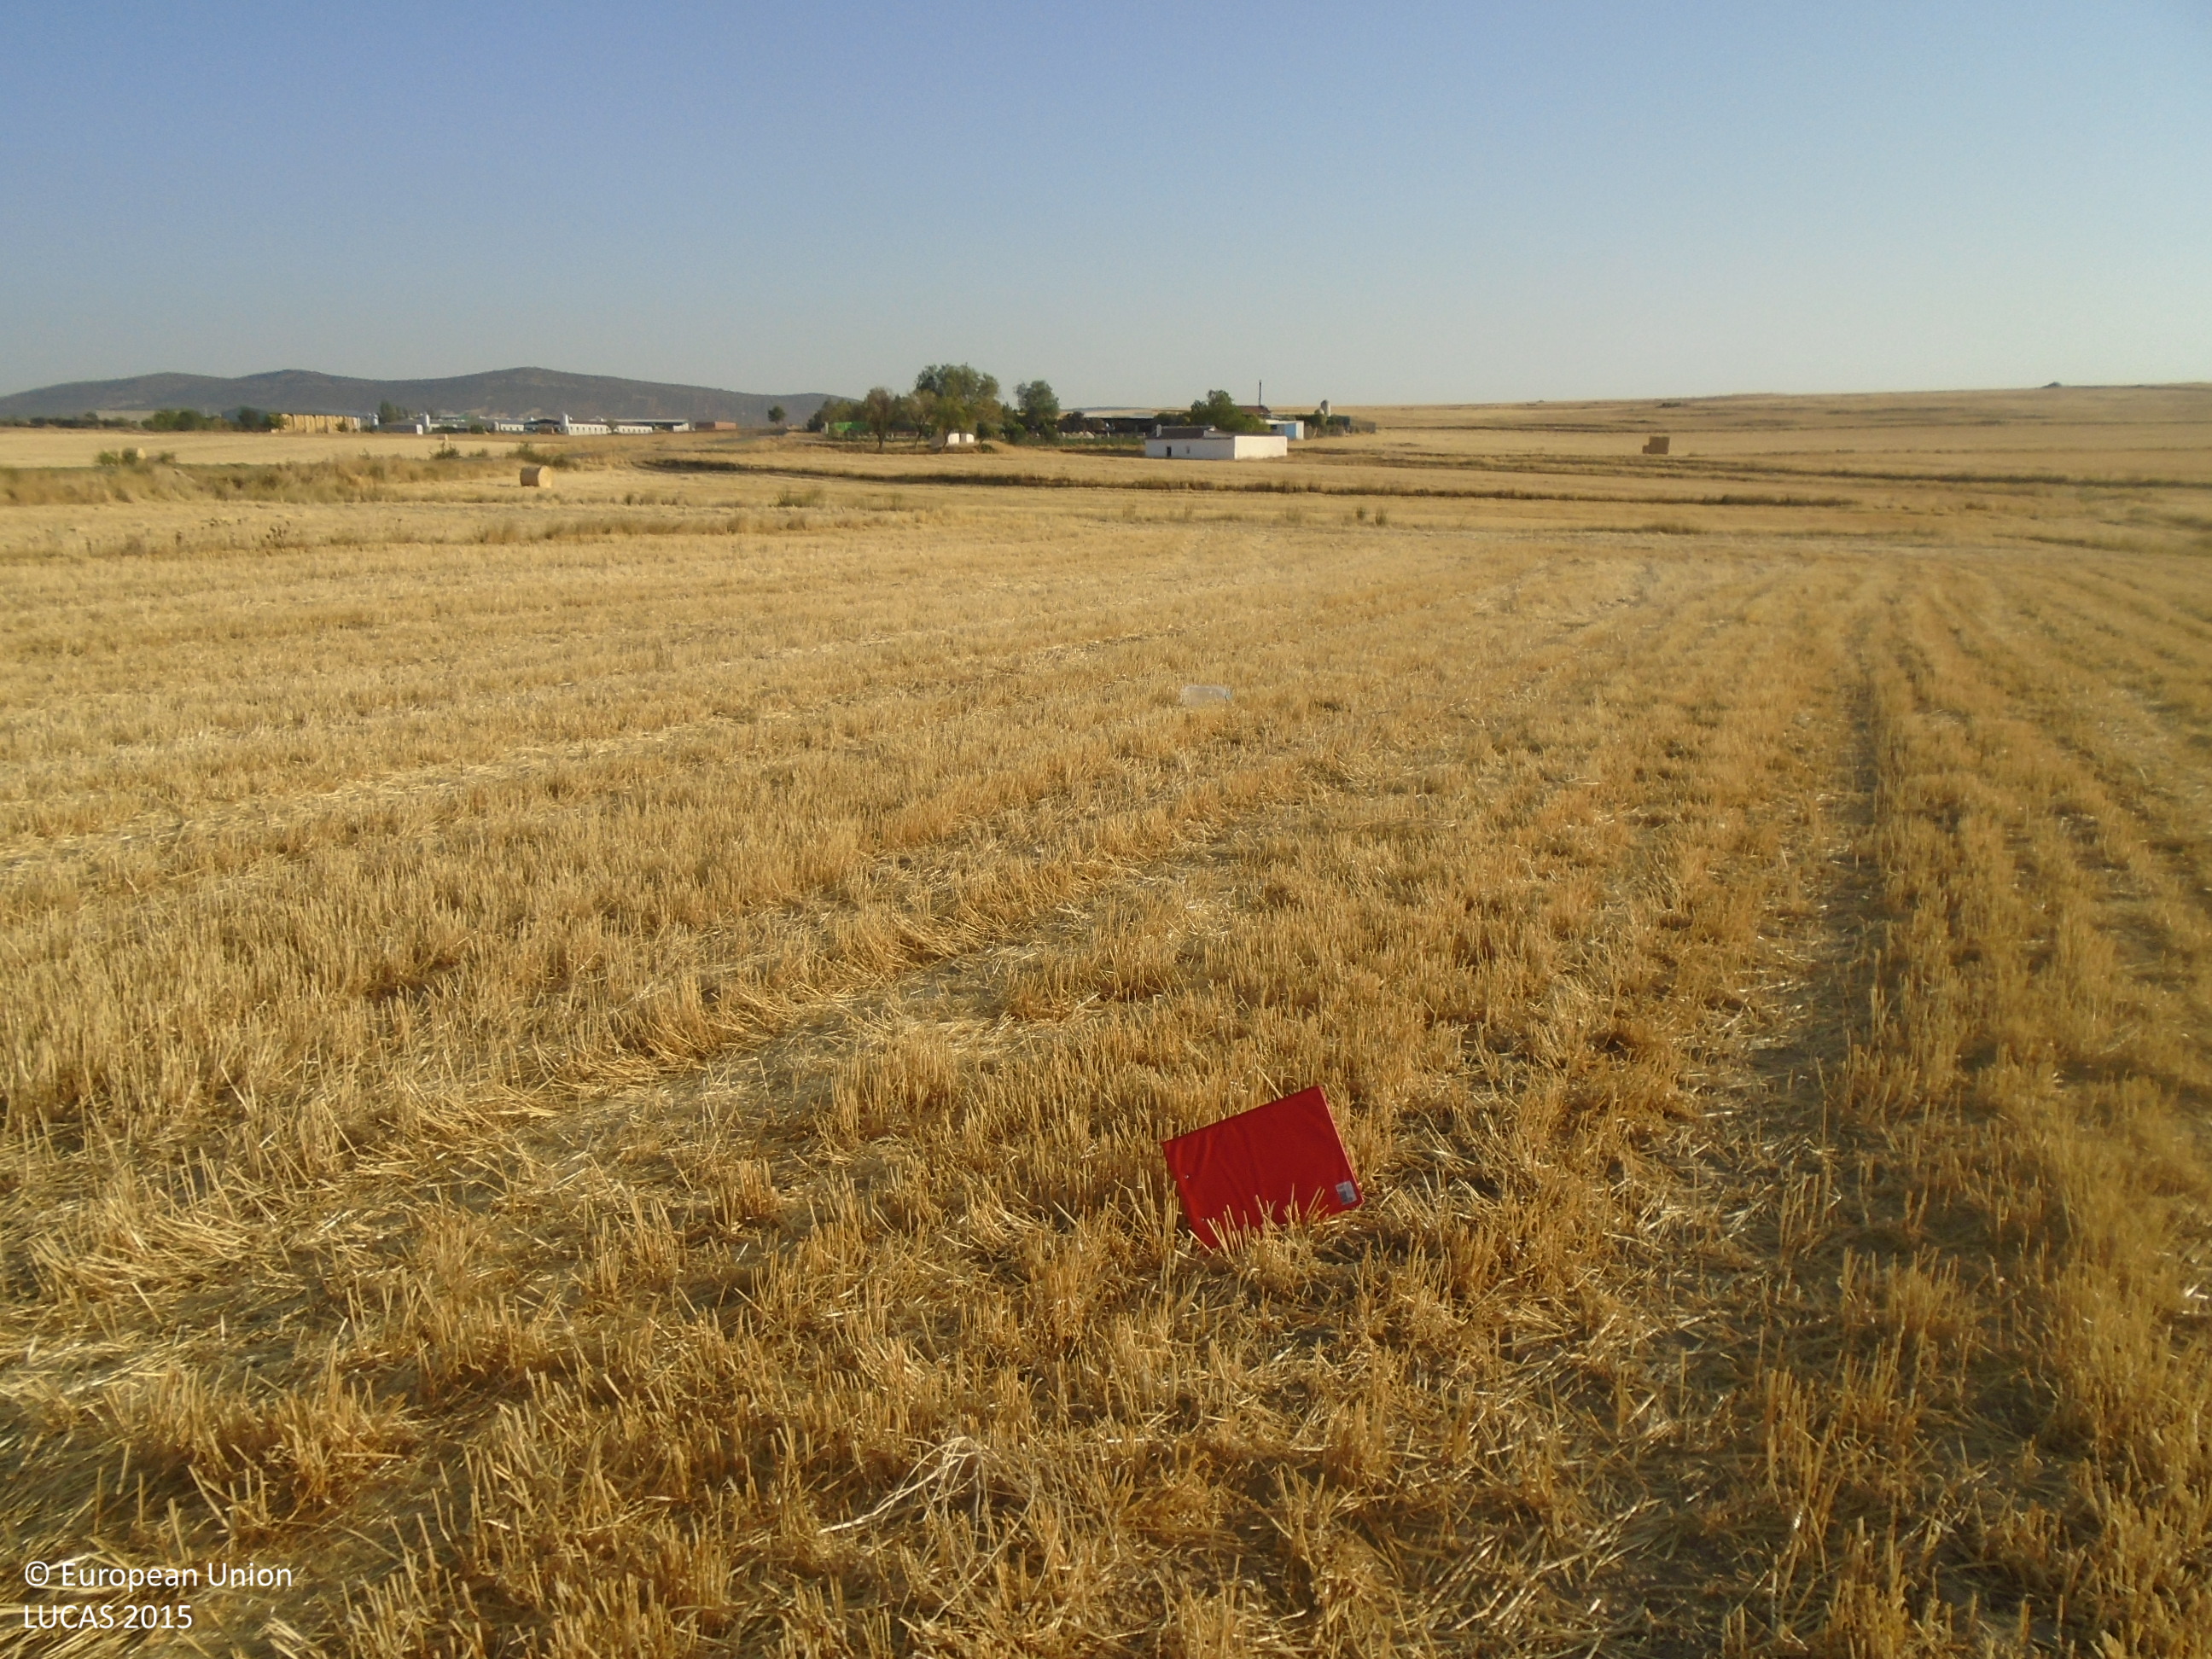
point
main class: Cropland
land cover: Barley
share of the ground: > 75 %
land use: Agriculture (excluding fallow land and kitchen gardens)
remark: Harvested field
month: July
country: ES
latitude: 39.3910
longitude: -3.7129
